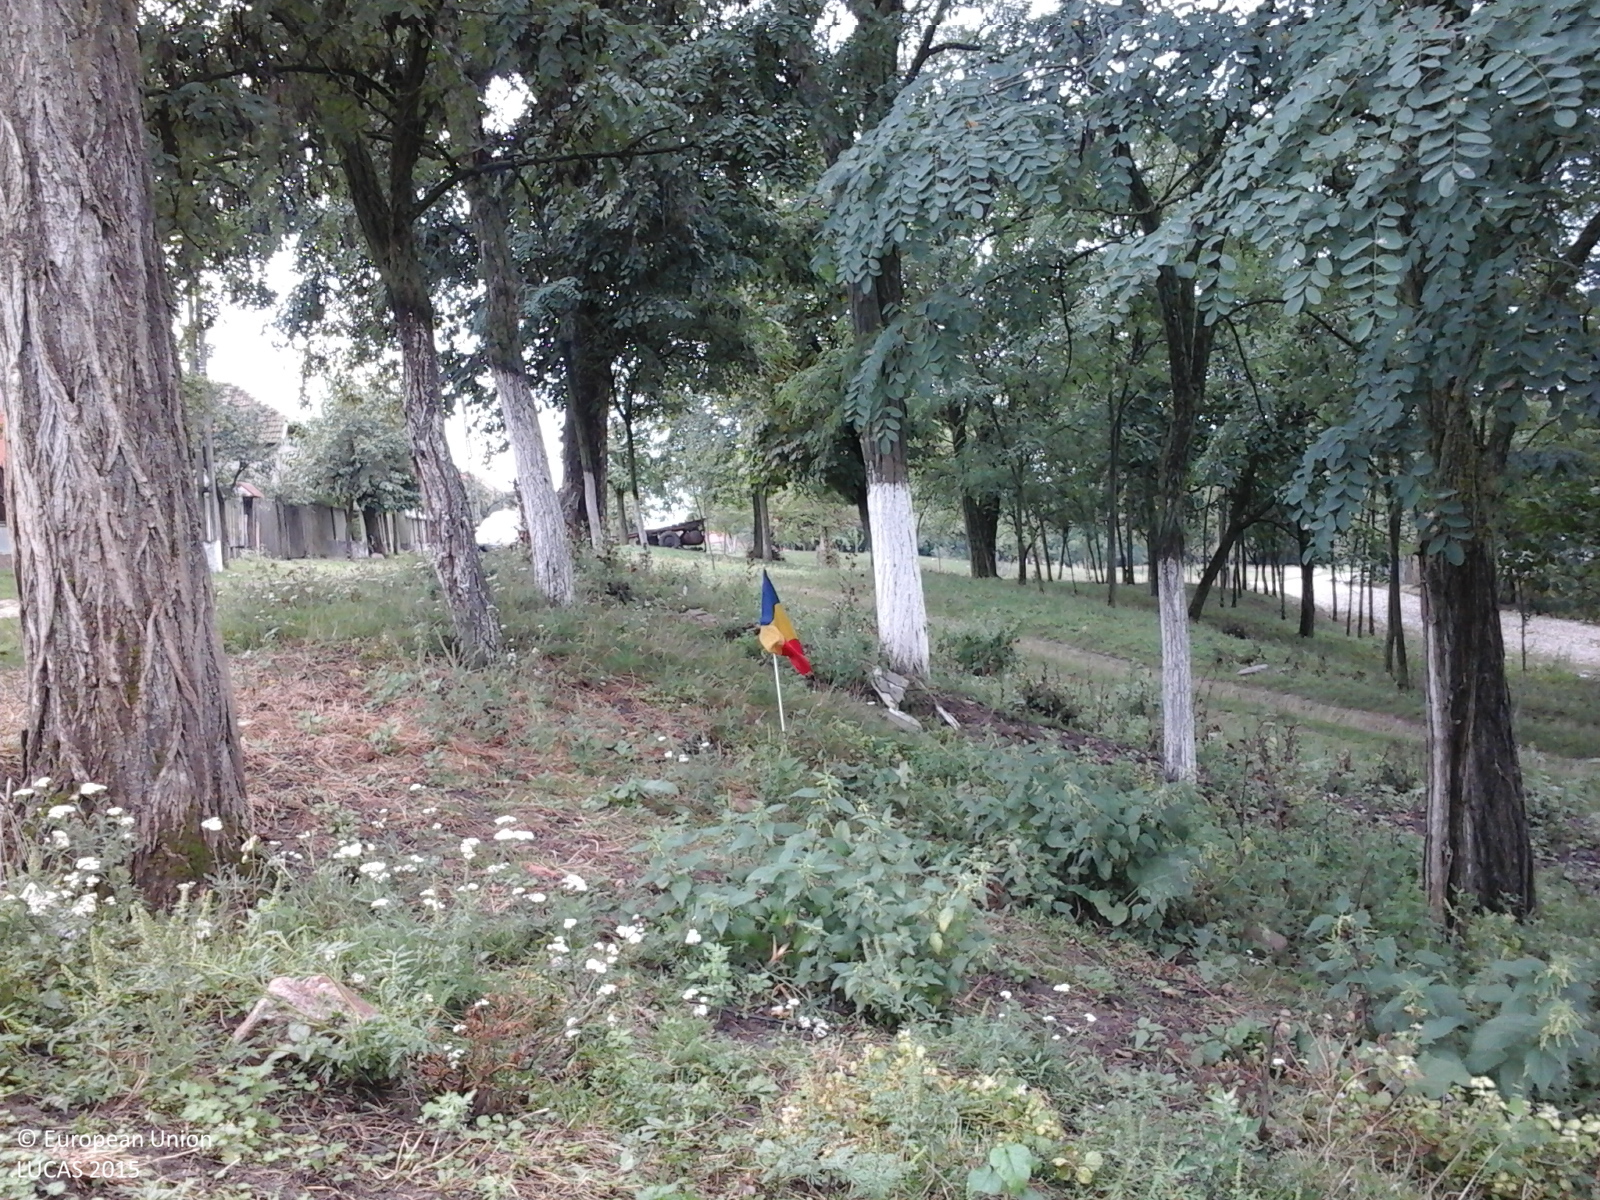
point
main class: Woodland
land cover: Broadleaved woodland
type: exotic forest
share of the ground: > 75 %
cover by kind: broadleaved forest trees 100 %
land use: Forestry
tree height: > 5 m
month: September
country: RO
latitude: 46.8411
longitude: 21.8053
